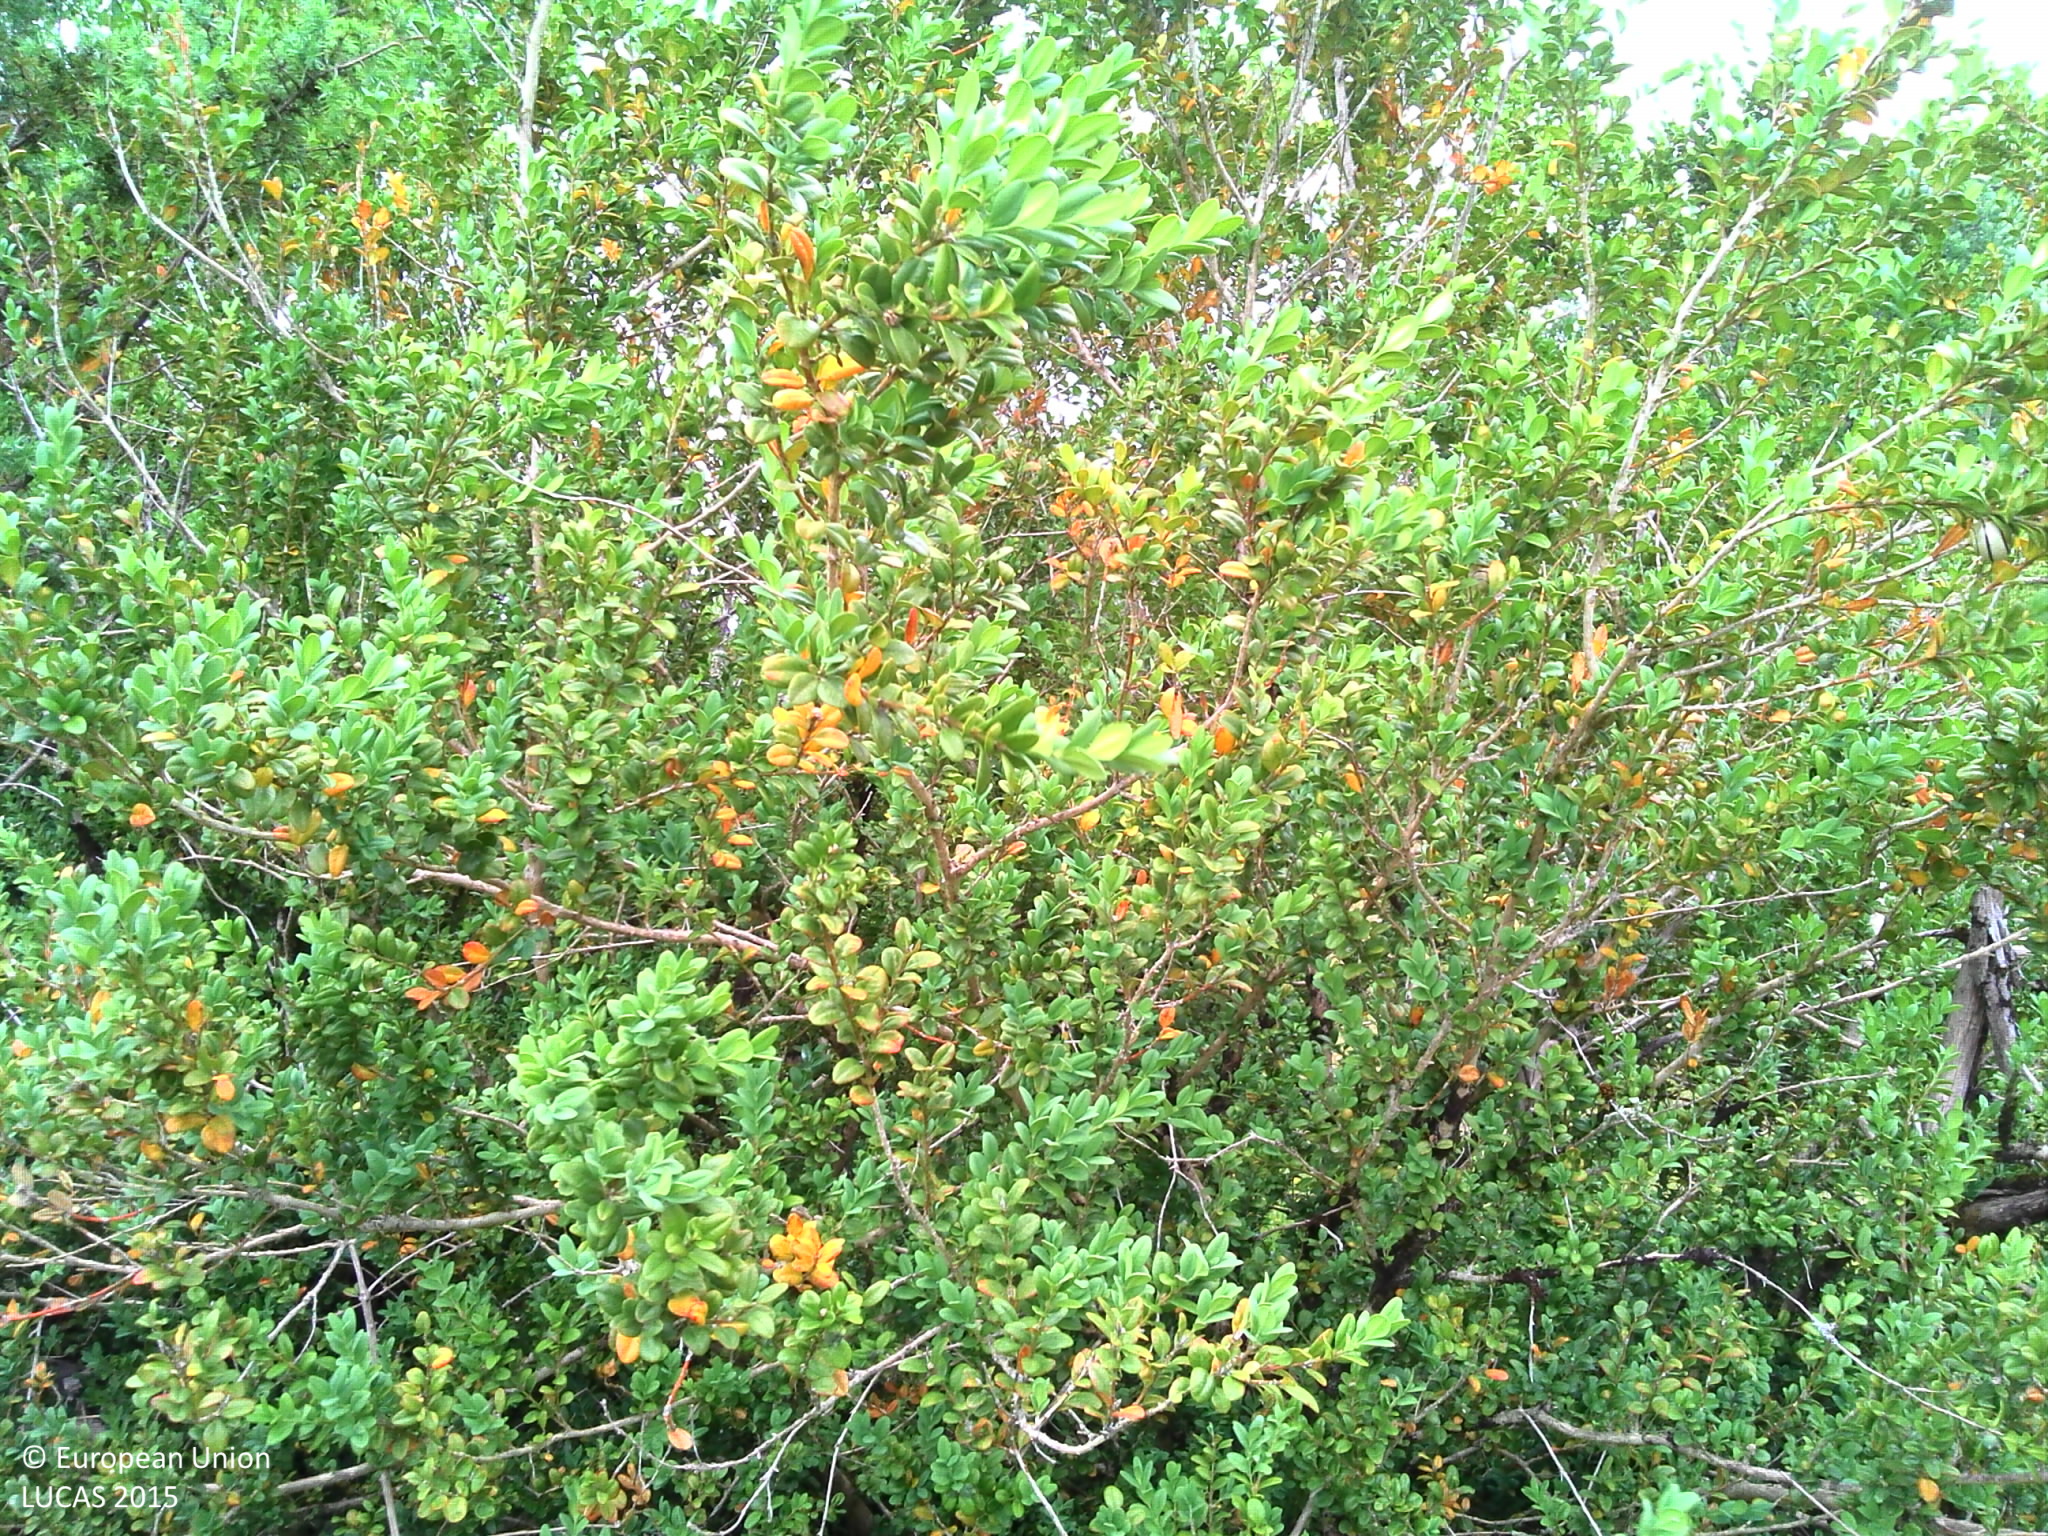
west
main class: Shrubland
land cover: Shrubland with sparse tree cover
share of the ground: > 75 %
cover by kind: shrubs 55 %, herbaceous plants 25 %, lichens and mosses 15 %, broadleaved forest trees 5 %
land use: Agriculture (excluding fallow land and kitchen gardens)
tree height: > 5 m
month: June
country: FR
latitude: 44.4678
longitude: 1.8926
